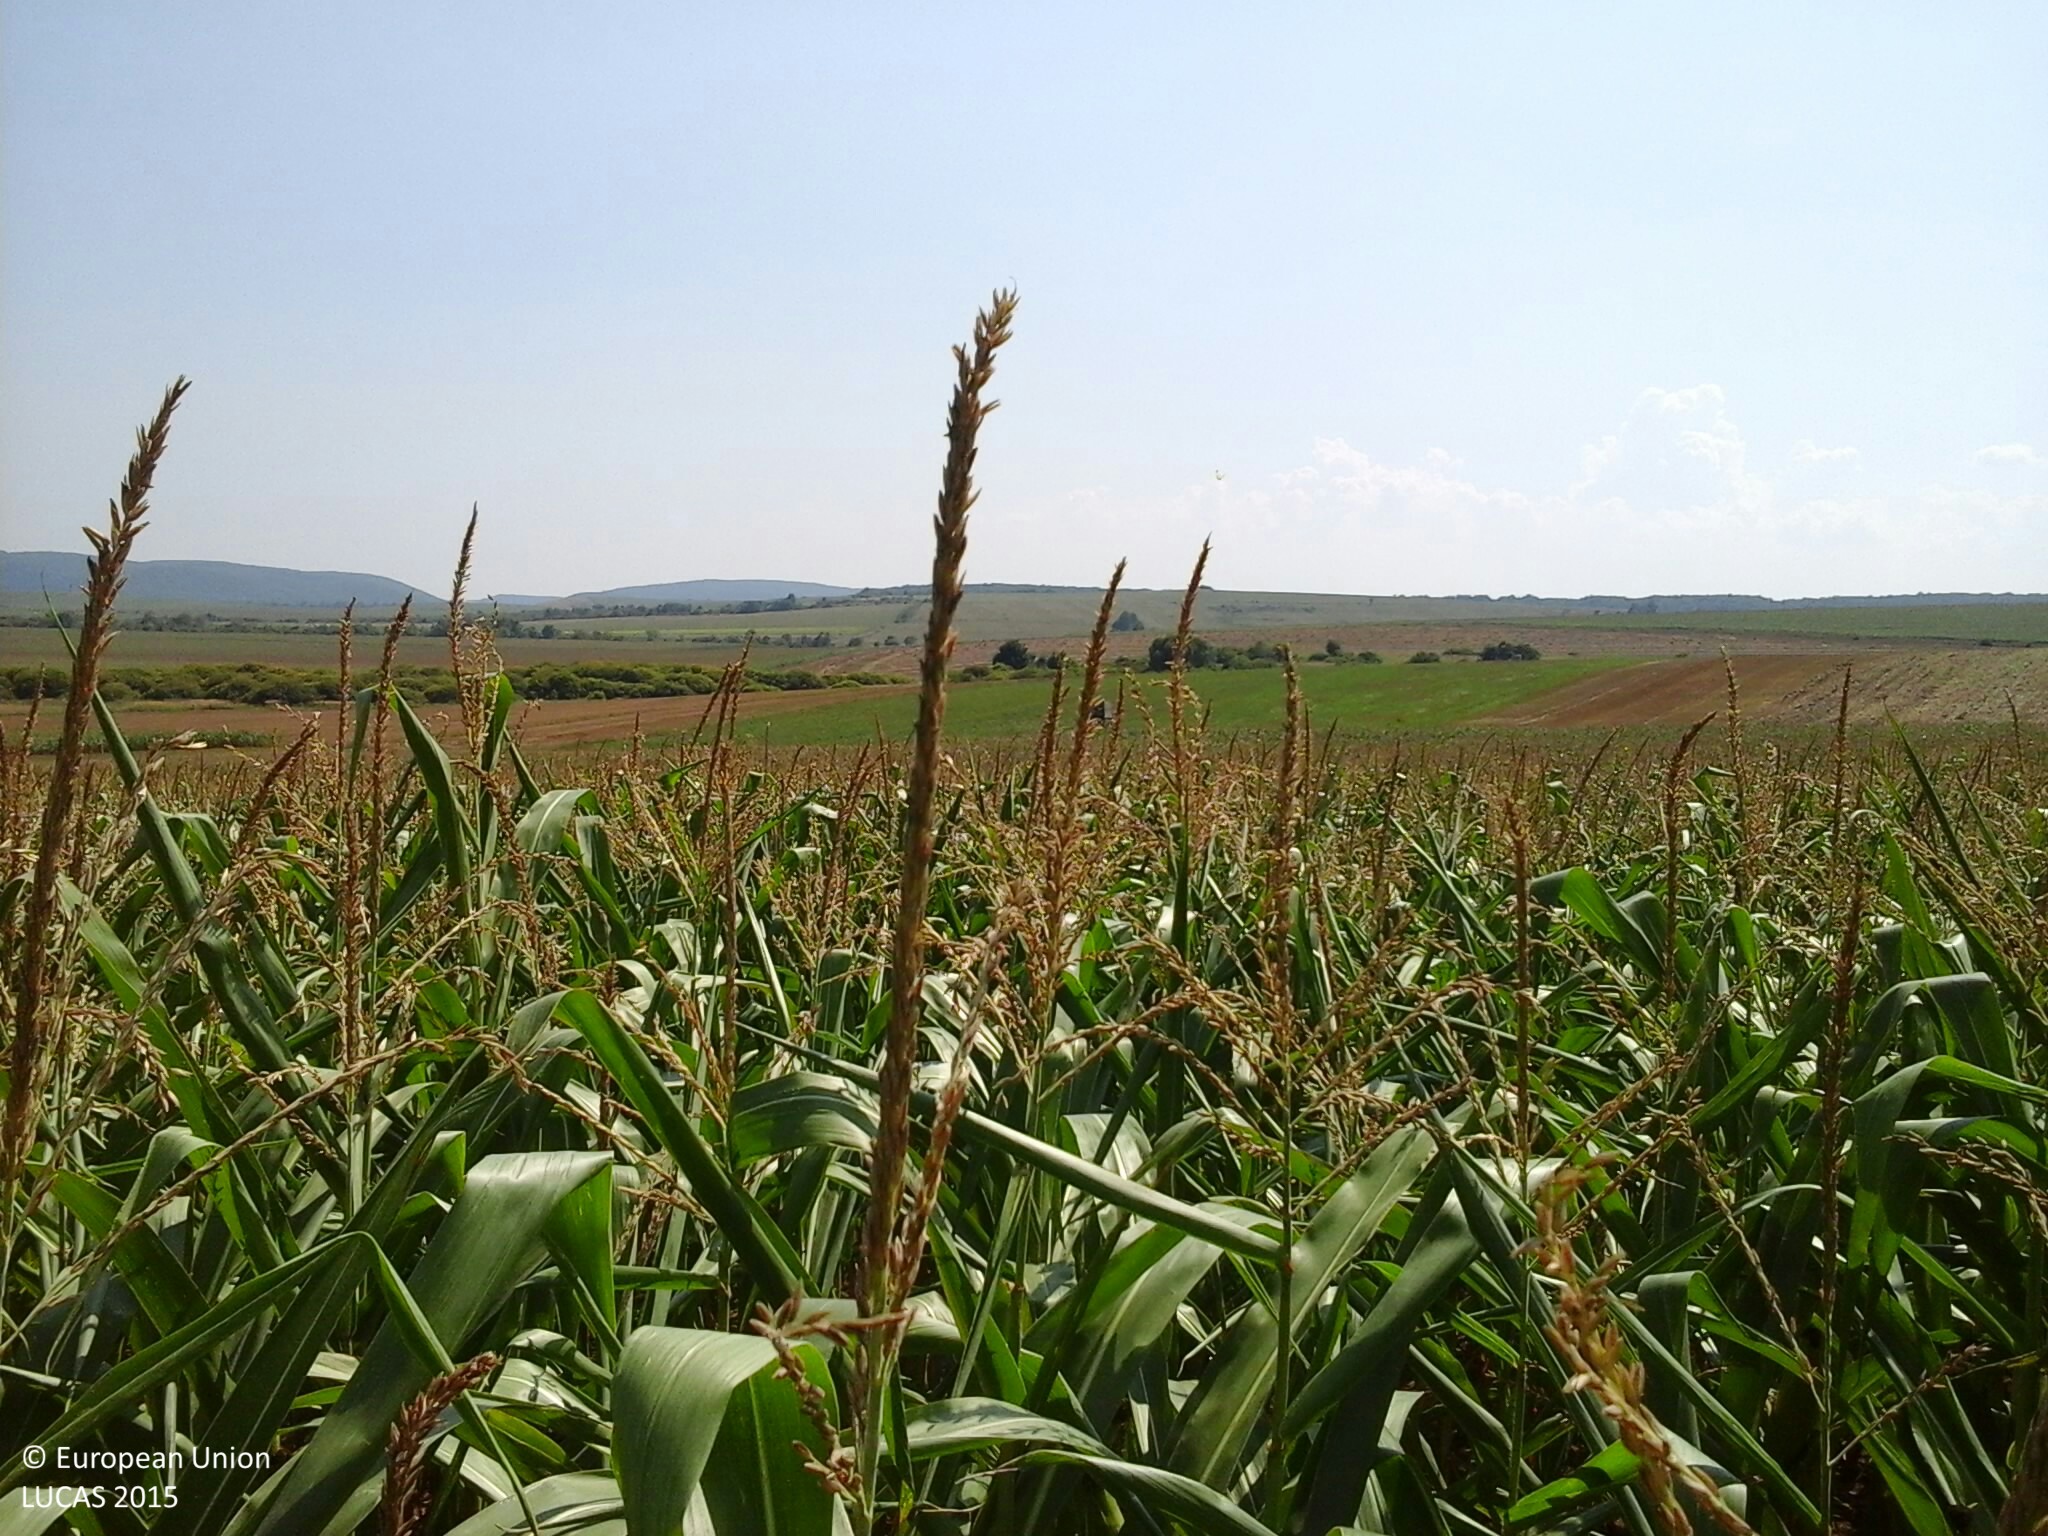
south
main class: Cropland
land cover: Maize
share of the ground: > 75 %
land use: Agriculture (excluding fallow land and kitchen gardens)
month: August
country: HU
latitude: 48.4272
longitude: 20.6997
